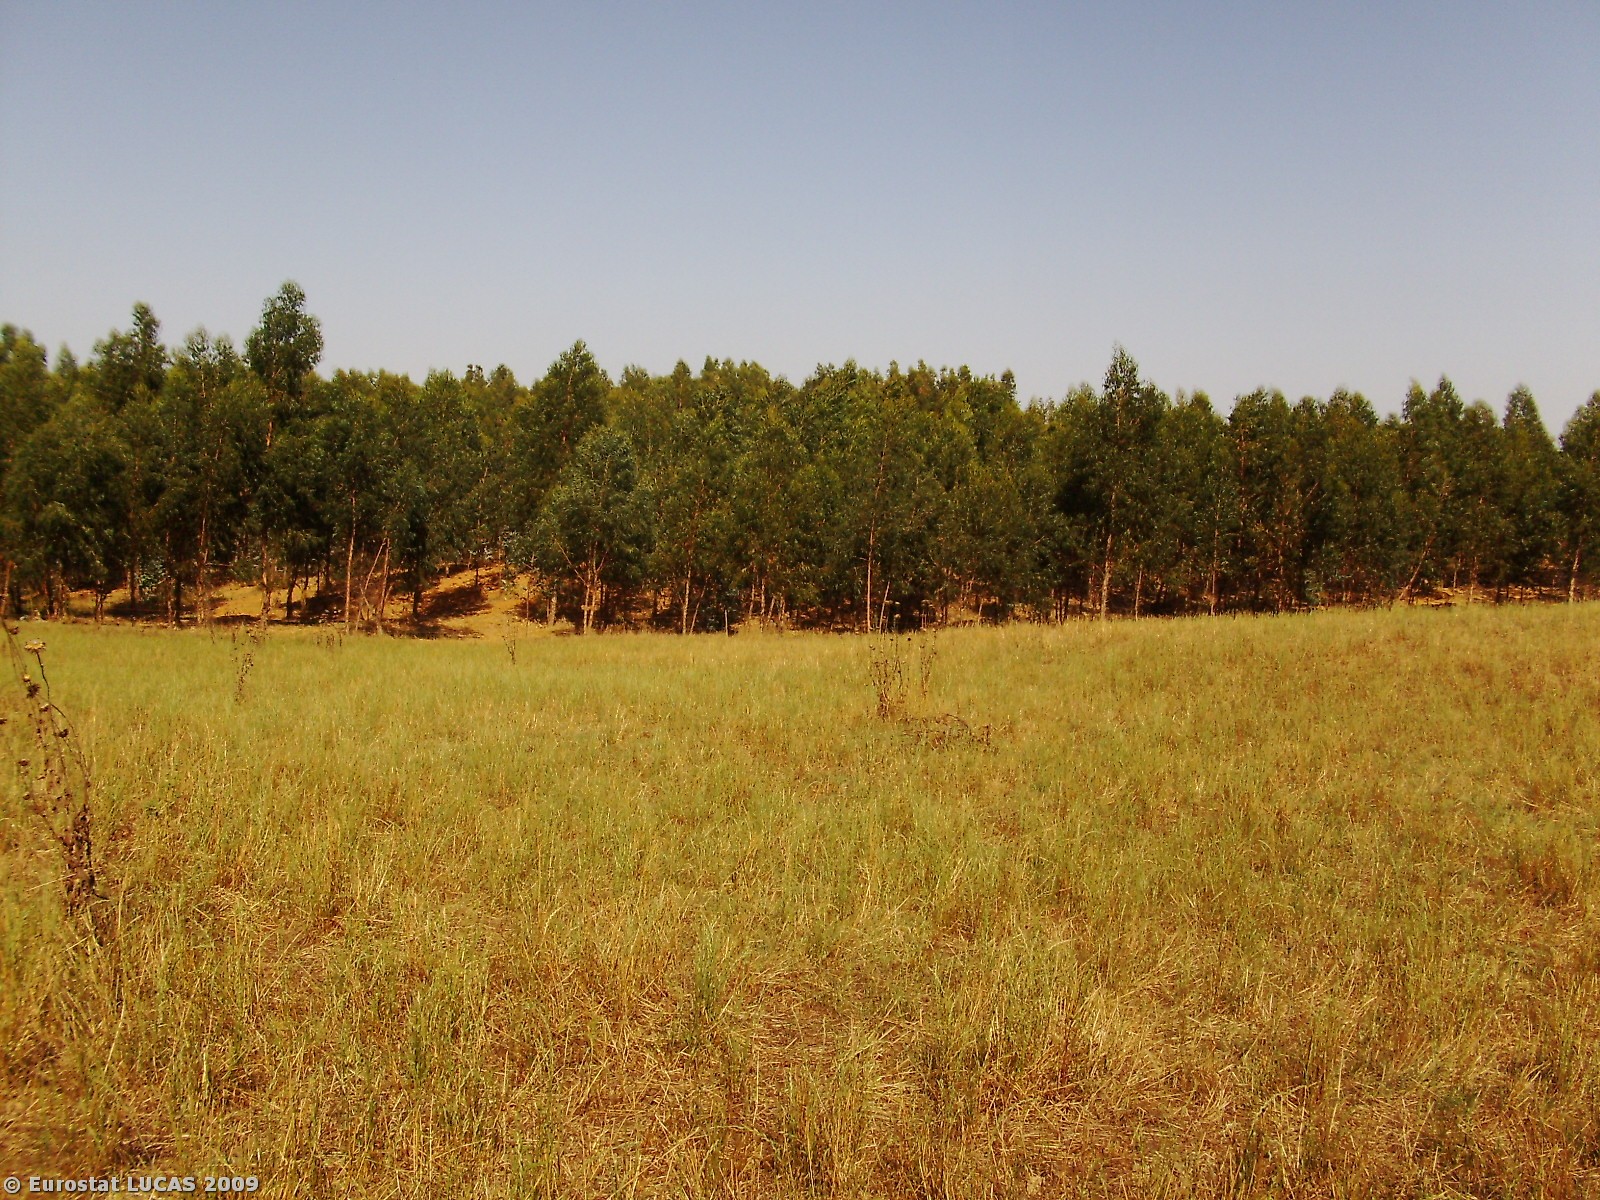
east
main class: Grassland
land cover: Grassland with sparse tree/shrub cover
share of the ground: > 75 %
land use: Agriculture (excluding fallow land and kitchen gardens)
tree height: > 5 m
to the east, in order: Grassland with sparse tree/shrub cover; Fences; Broadleaved woodland; Spontaneously vegetated surfaces; Artificial constructions in urban areas
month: July
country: PT
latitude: 39.3312
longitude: -8.8375
